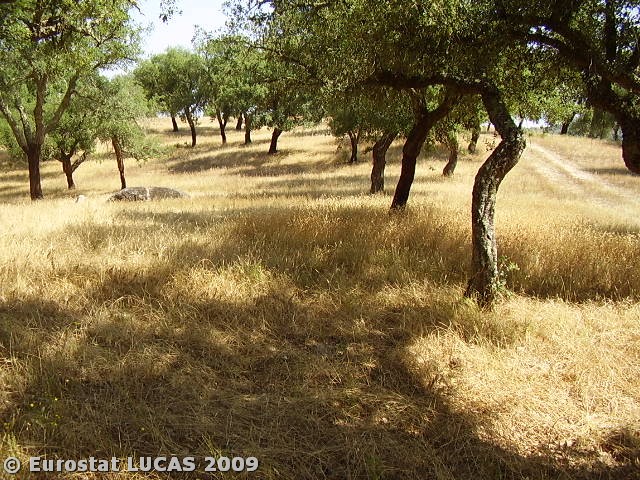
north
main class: Woodland
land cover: Broadleaved woodland
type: broadleaved evergreen forest
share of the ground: 50 - 75 %
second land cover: Spontaneously vegetated surfaces
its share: 25 - 50 %
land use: Forestry
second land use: Fallow land
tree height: > 5 m
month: June
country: PT
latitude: 38.7738
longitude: -7.9896
